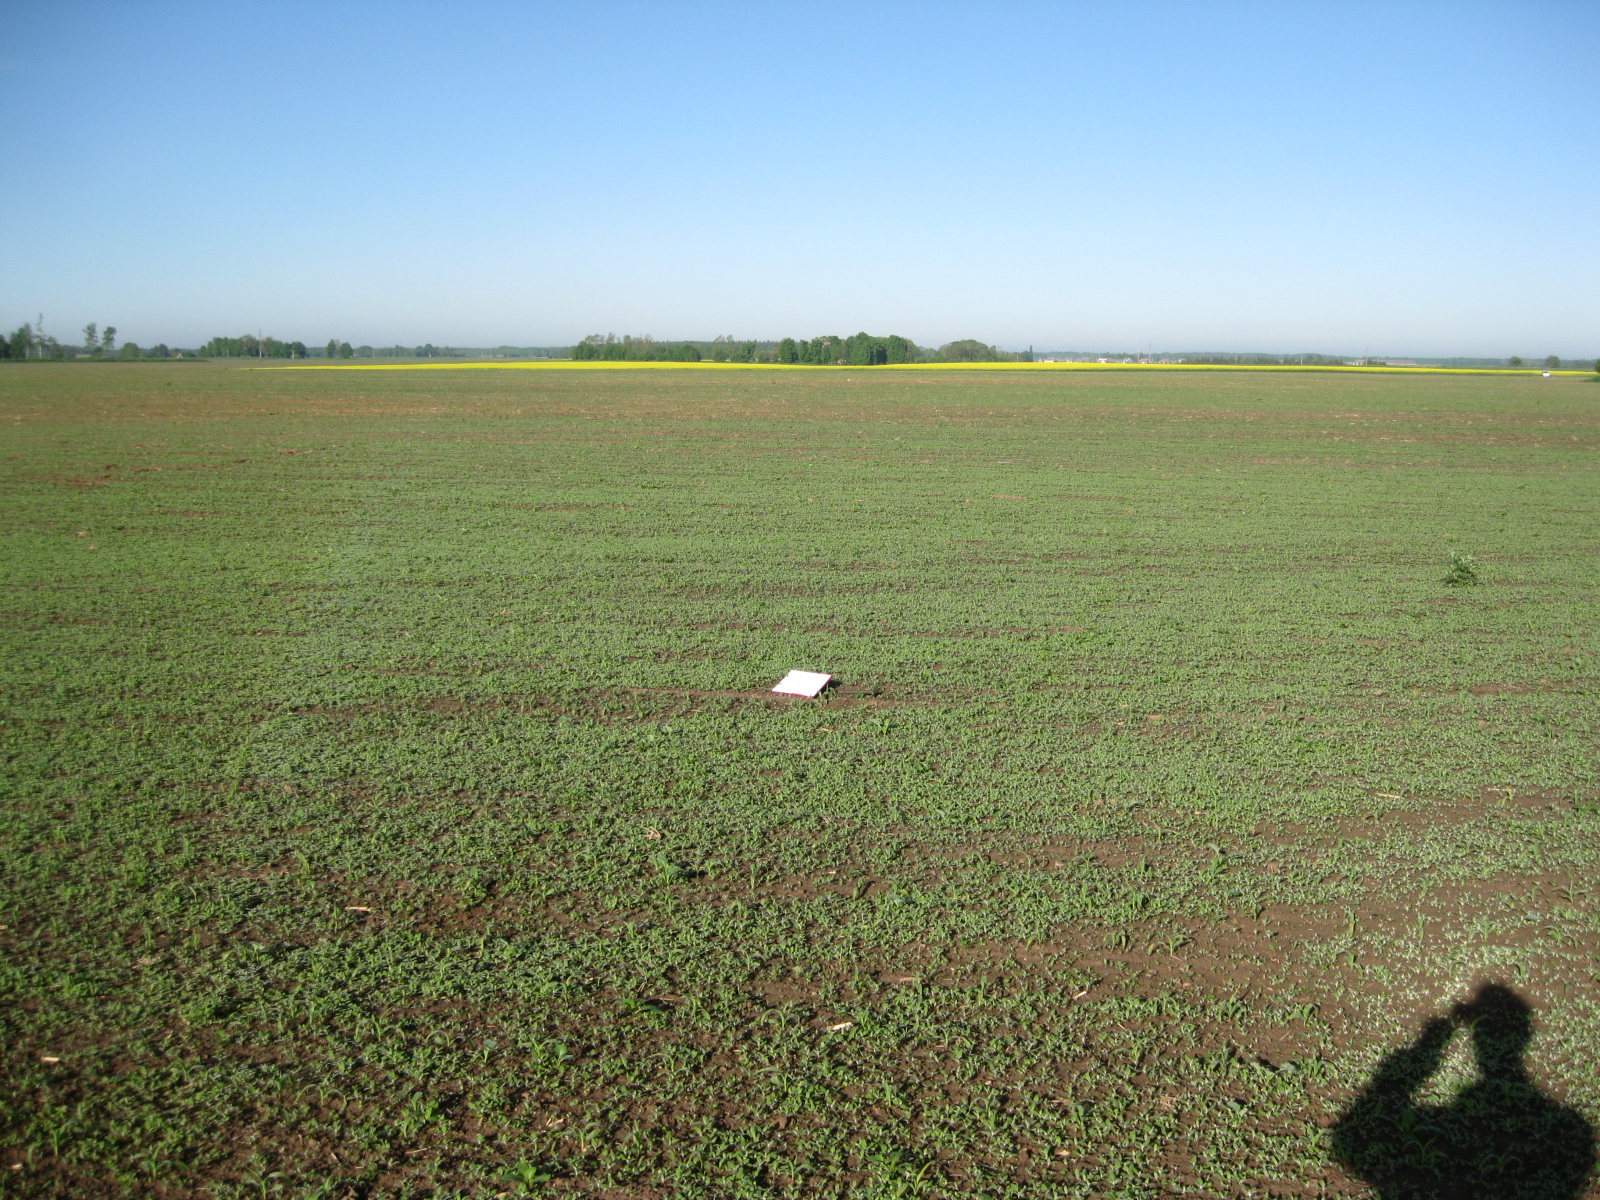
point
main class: Cropland
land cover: Maize
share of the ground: 25 - 50 %
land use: Agriculture (excluding fallow land and kitchen gardens)
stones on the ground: < 10 %
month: May
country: LT
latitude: 56.1659
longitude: 24.4777
